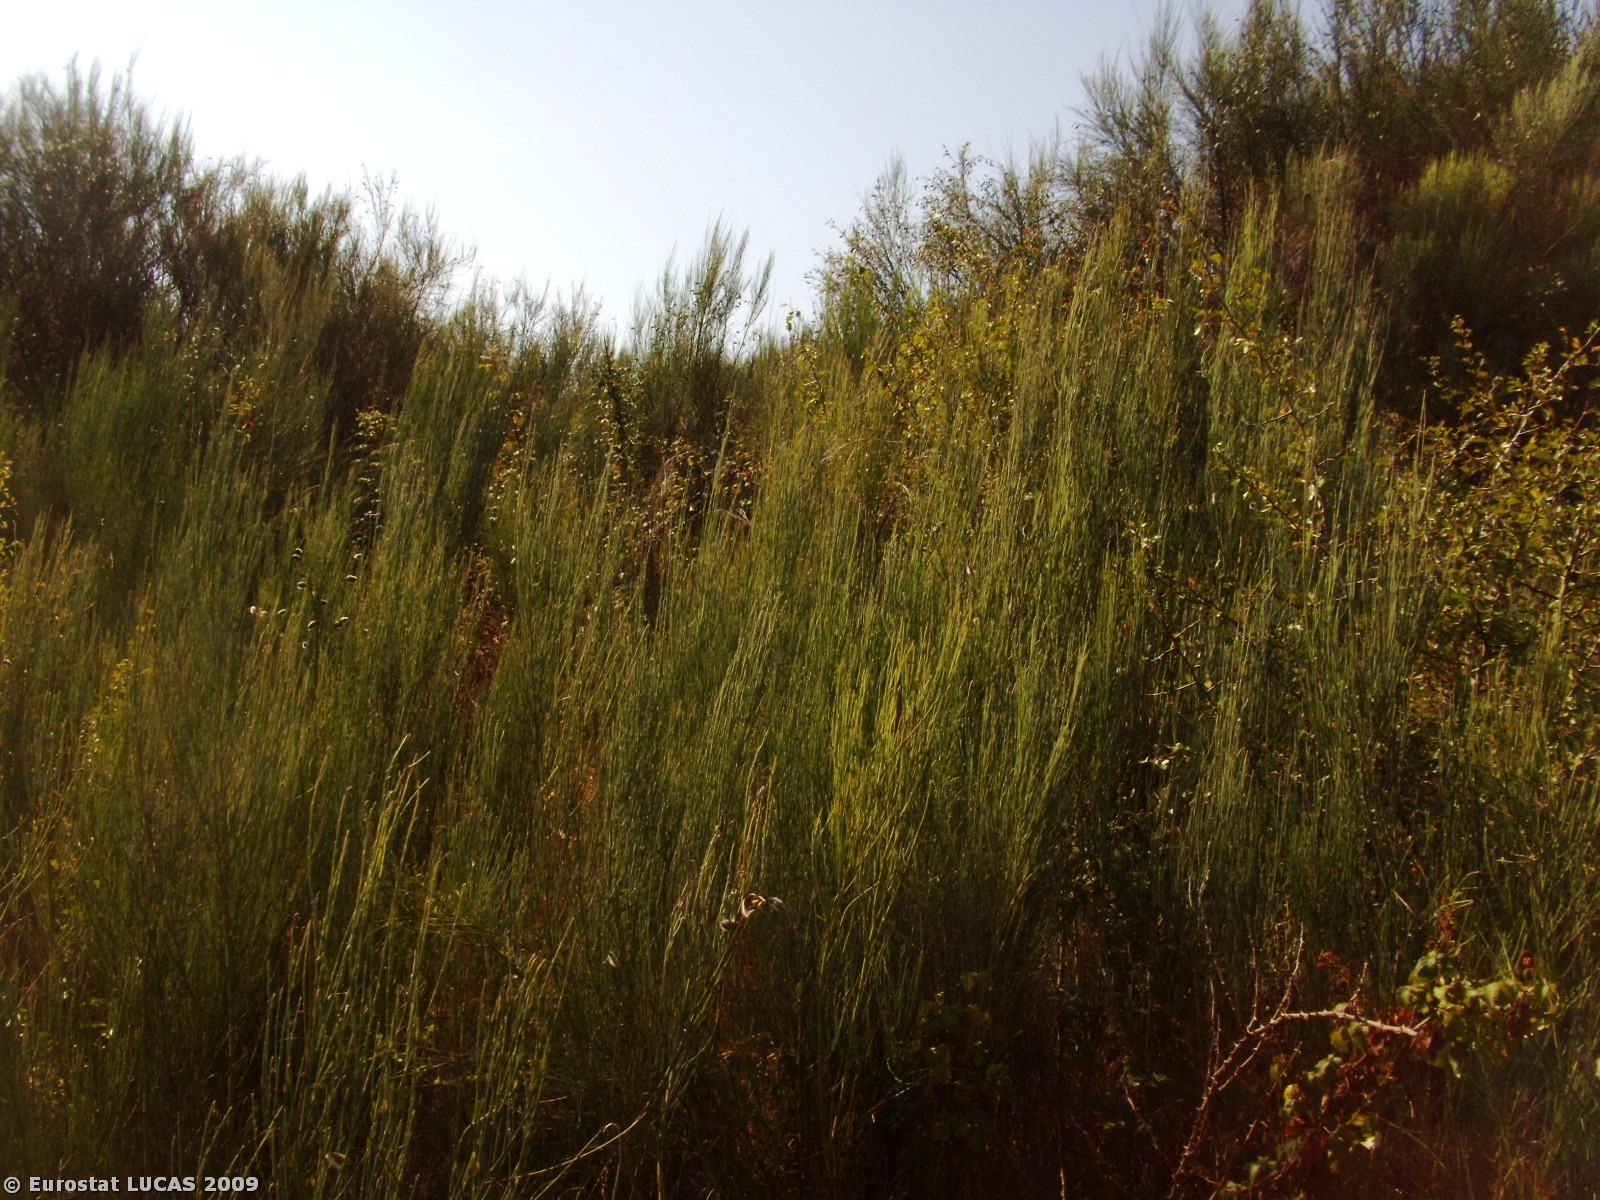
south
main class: Shrubland
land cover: Shrubland without tree cover
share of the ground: > 75 %
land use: Fallow land
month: August
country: PT
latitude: 40.1863
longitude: -7.6449
